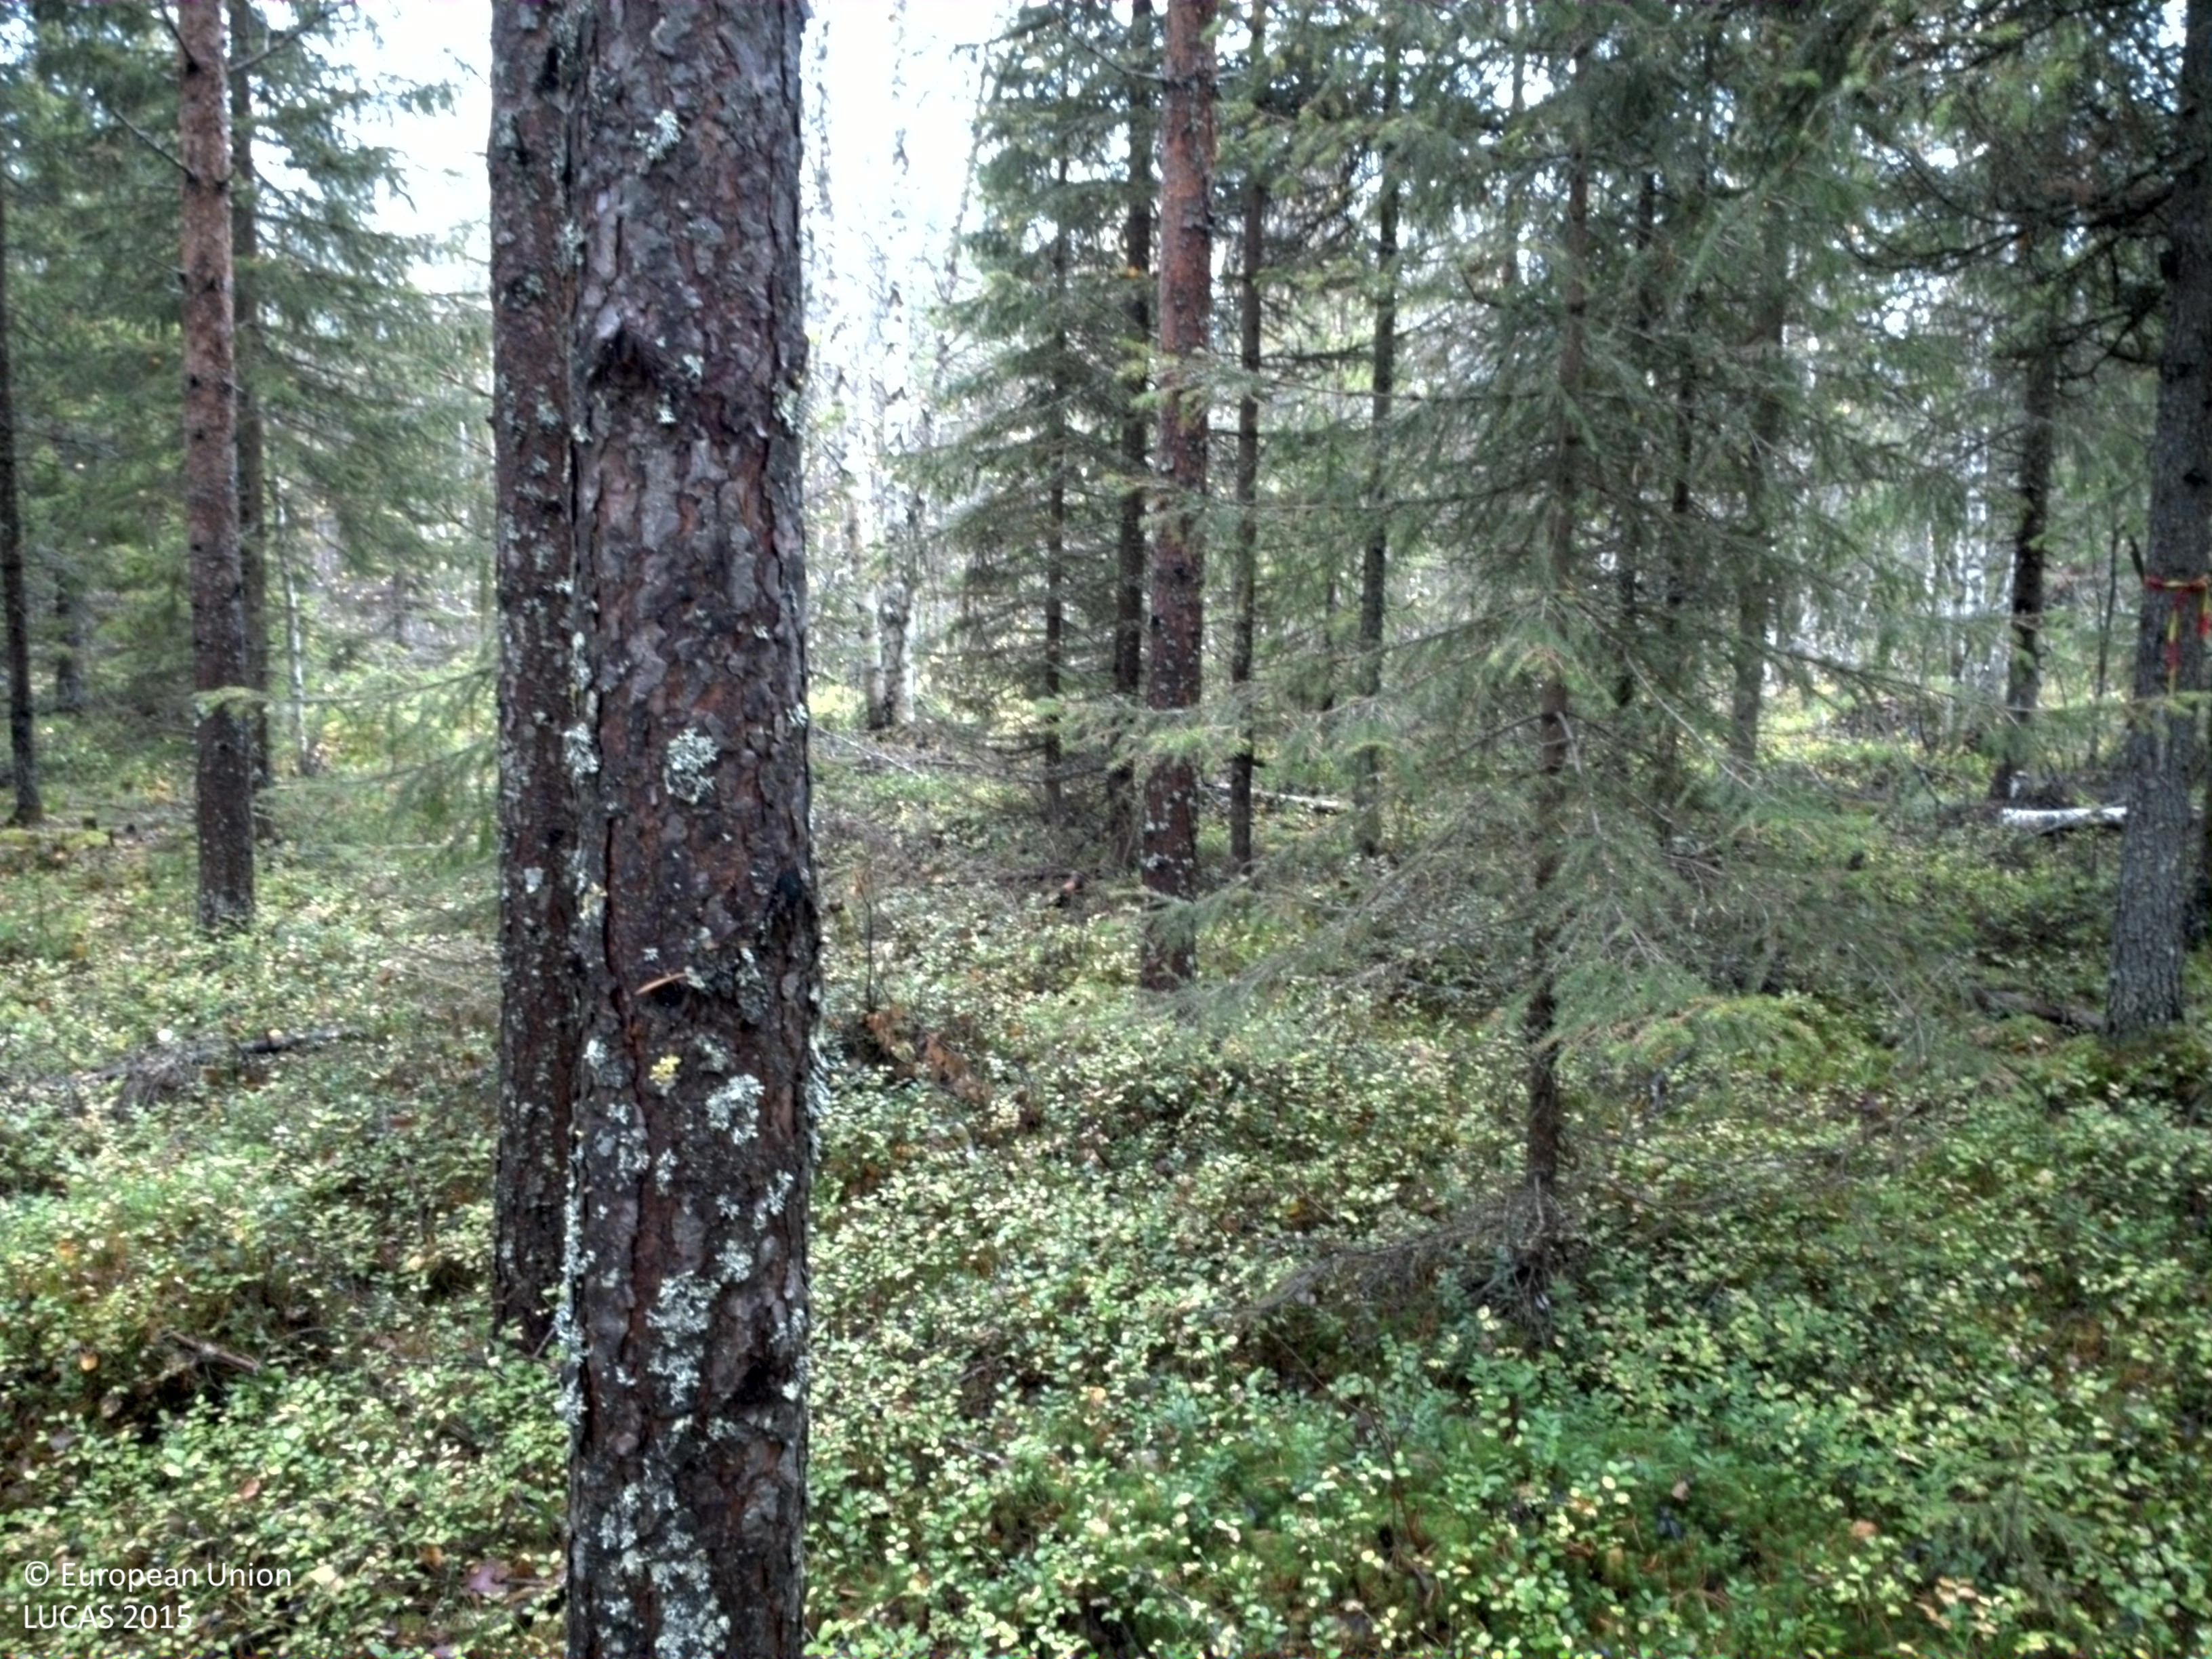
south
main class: Woodland
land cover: Pine dominated coniferous woodland
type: boreal forest
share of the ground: 25 - 50 %
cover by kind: shrubs 60 %, coniferous forest trees 40 %
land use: Forestry
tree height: > 5 m
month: September
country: SE
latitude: 65.6926
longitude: 22.1046
